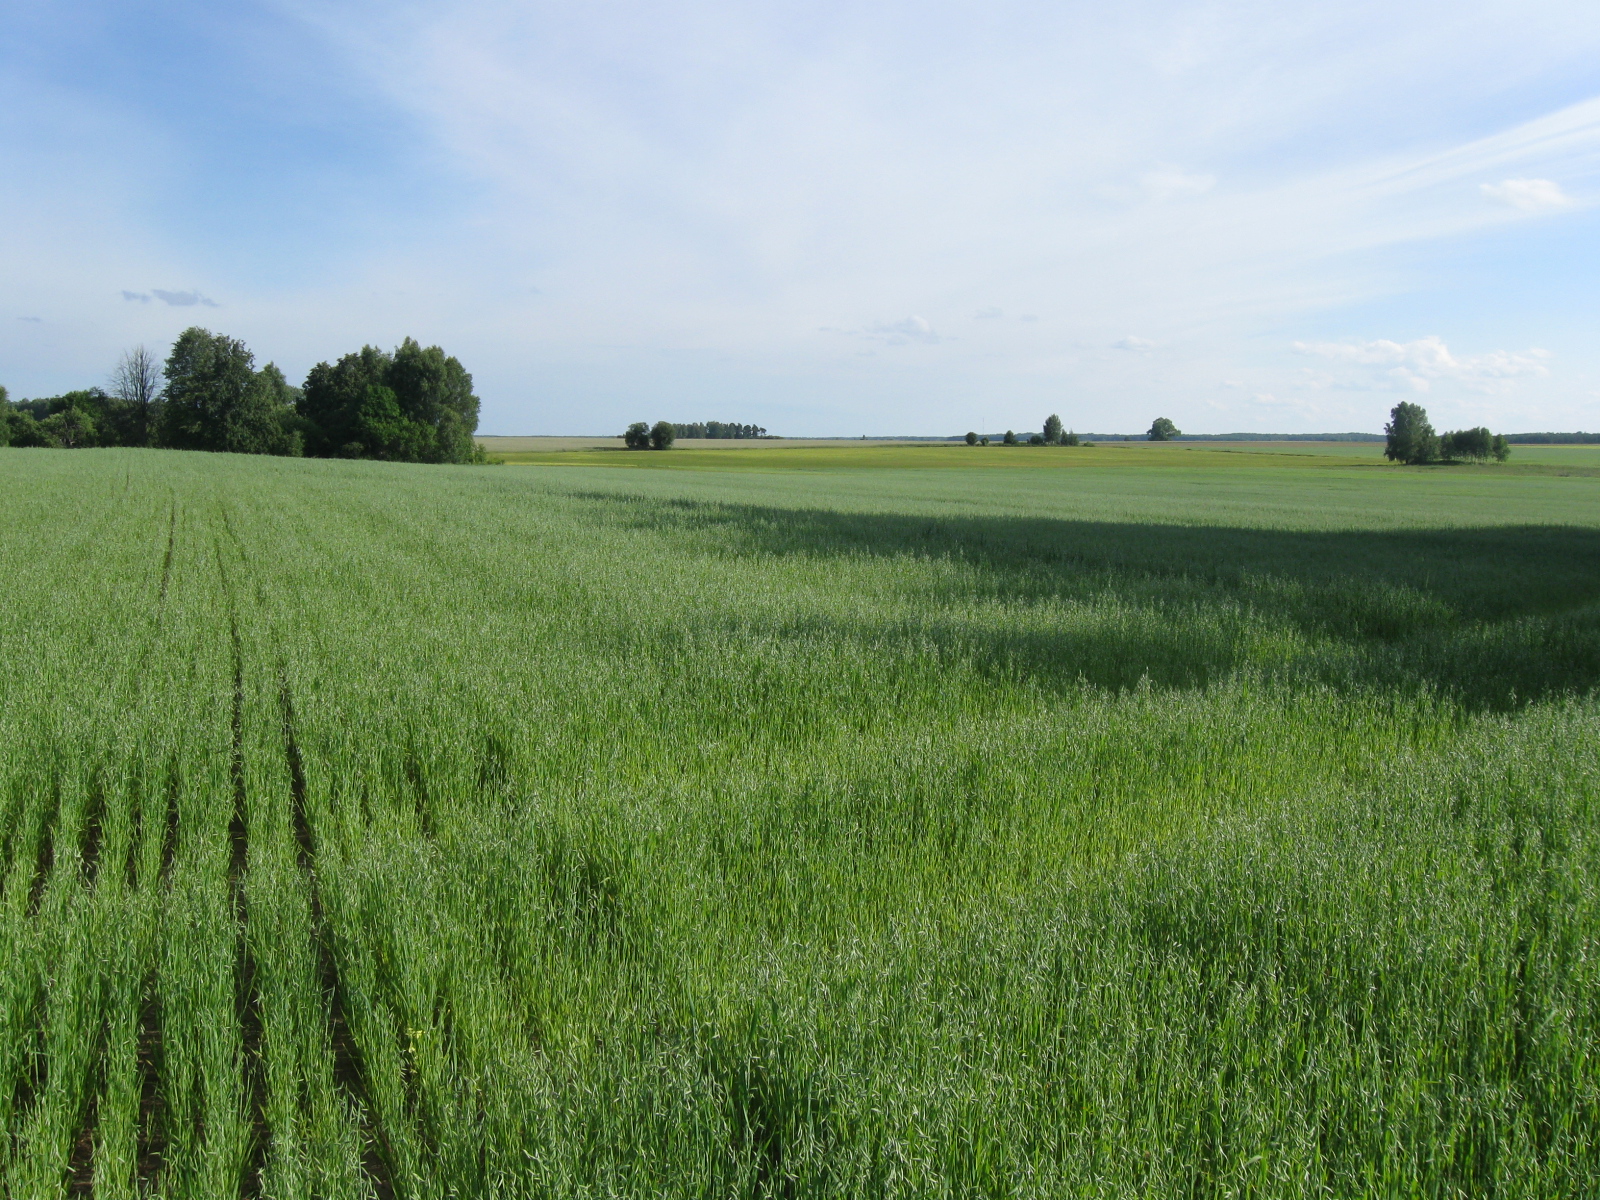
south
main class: Cropland
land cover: Oats
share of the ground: > 75 %
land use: Agriculture (excluding fallow land and kitchen gardens)
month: June
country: LT
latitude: 54.1727
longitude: 24.7704
